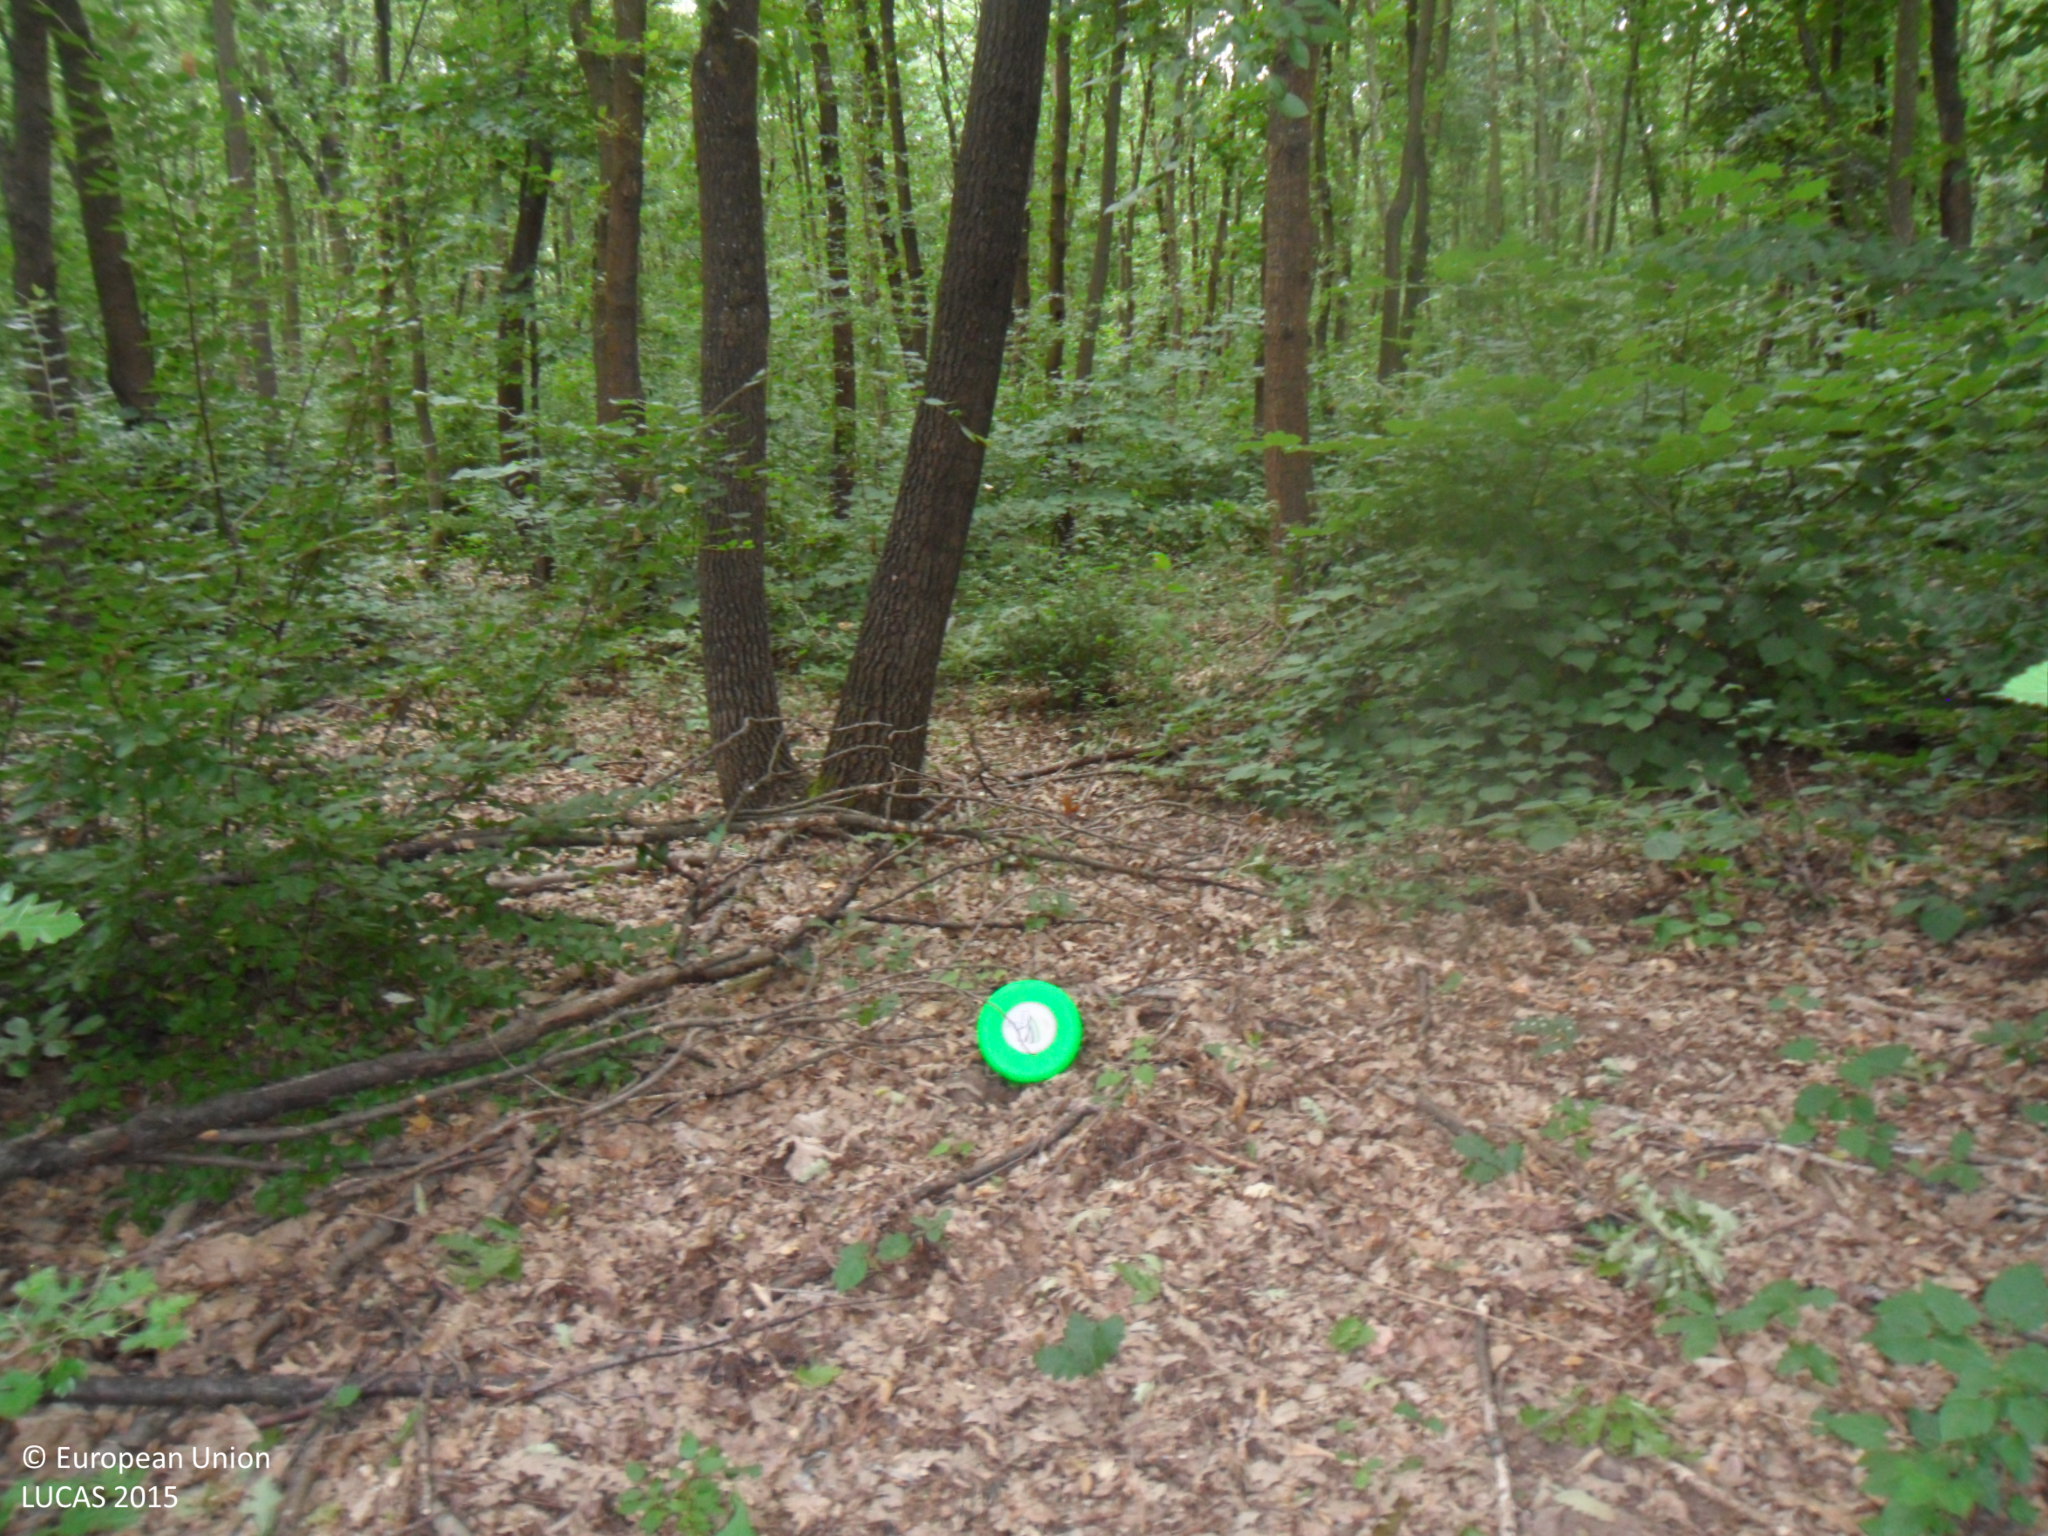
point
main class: Woodland
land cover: Broadleaved woodland
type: mesophytic deciduous forest
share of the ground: > 75 %
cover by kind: broadleaved forest trees 100 %
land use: Forestry
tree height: > 5 m
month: June
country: BG
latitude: 43.1335
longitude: 26.9157
